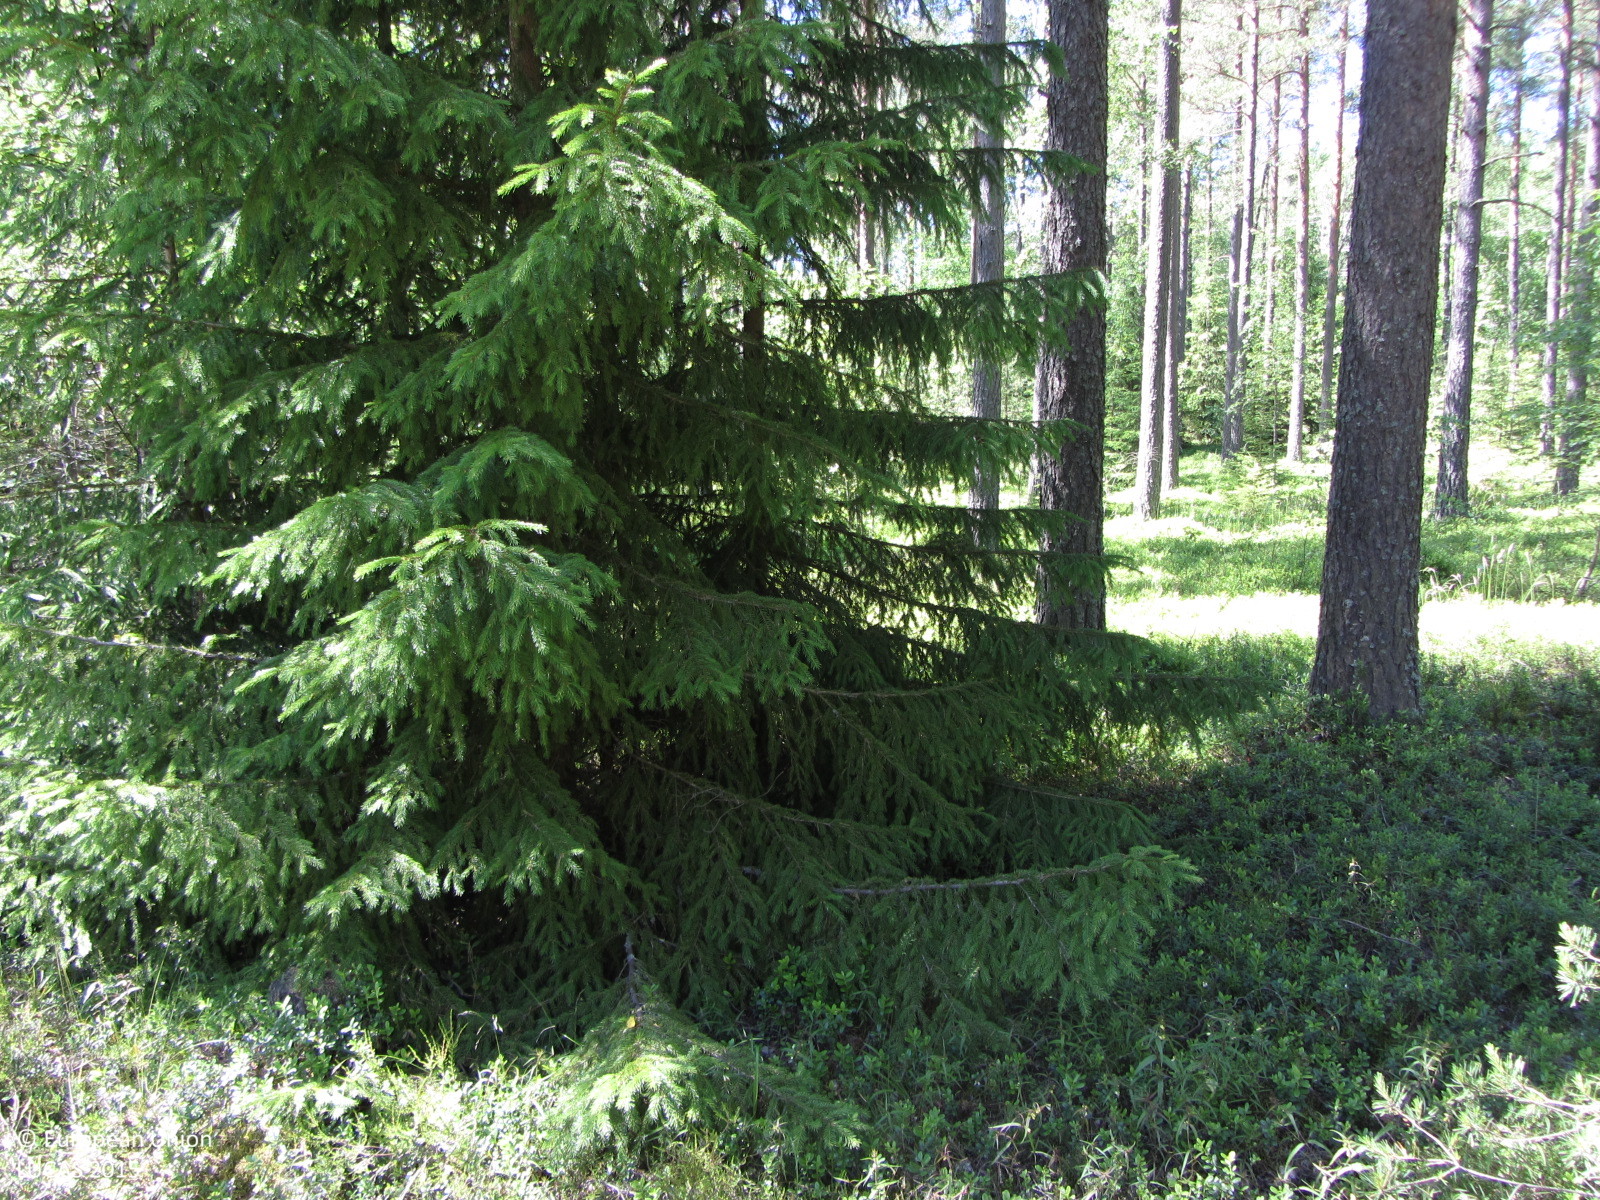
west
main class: Woodland
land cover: Pine dominated coniferous woodland
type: boreal forest
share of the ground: > 75 %
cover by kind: coniferous forest trees 80 %, broadleaved forest trees 10 %, shrubs 5 %, herbaceous plants 5 %
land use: Forestry
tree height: > 5 m
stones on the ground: < 10 %
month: July
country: FI
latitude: 59.9303
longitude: 23.3097
